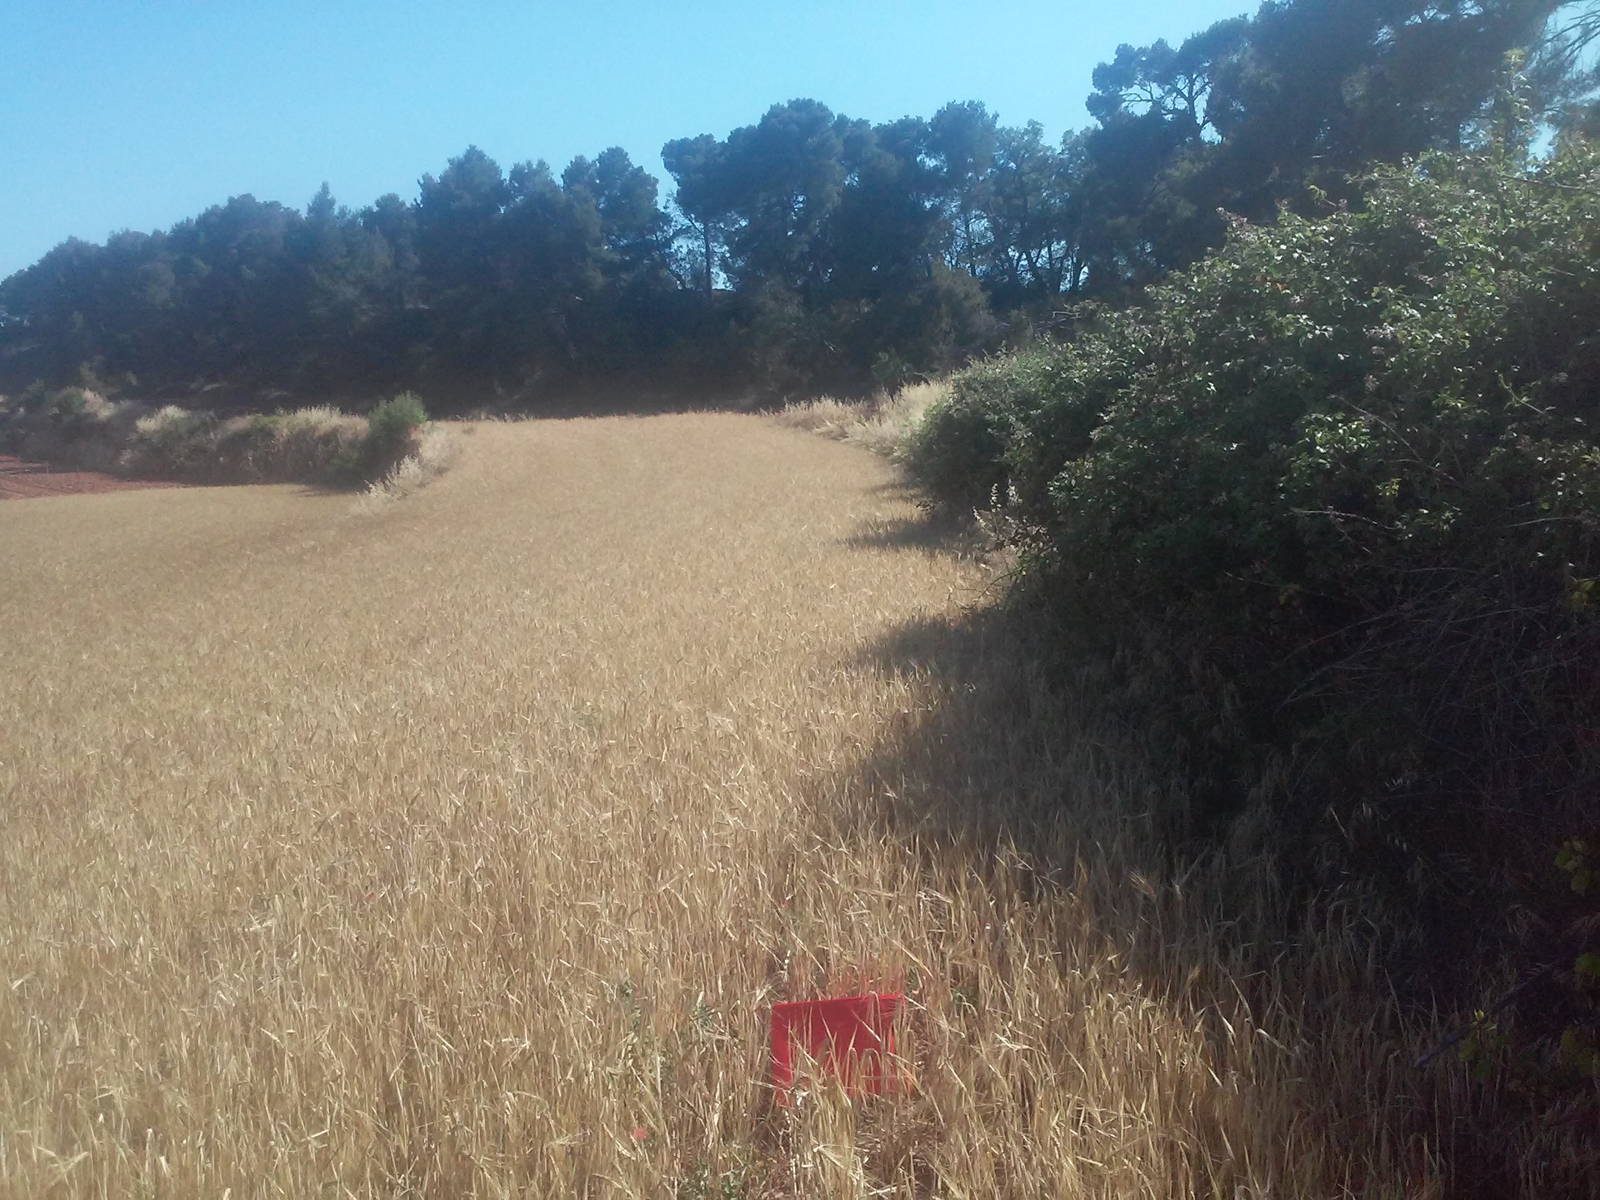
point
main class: Cropland
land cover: Barley
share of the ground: 50 - 75 %
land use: Agriculture (excluding fallow land and kitchen gardens)
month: June
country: ES
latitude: 41.4724
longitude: 1.2139
